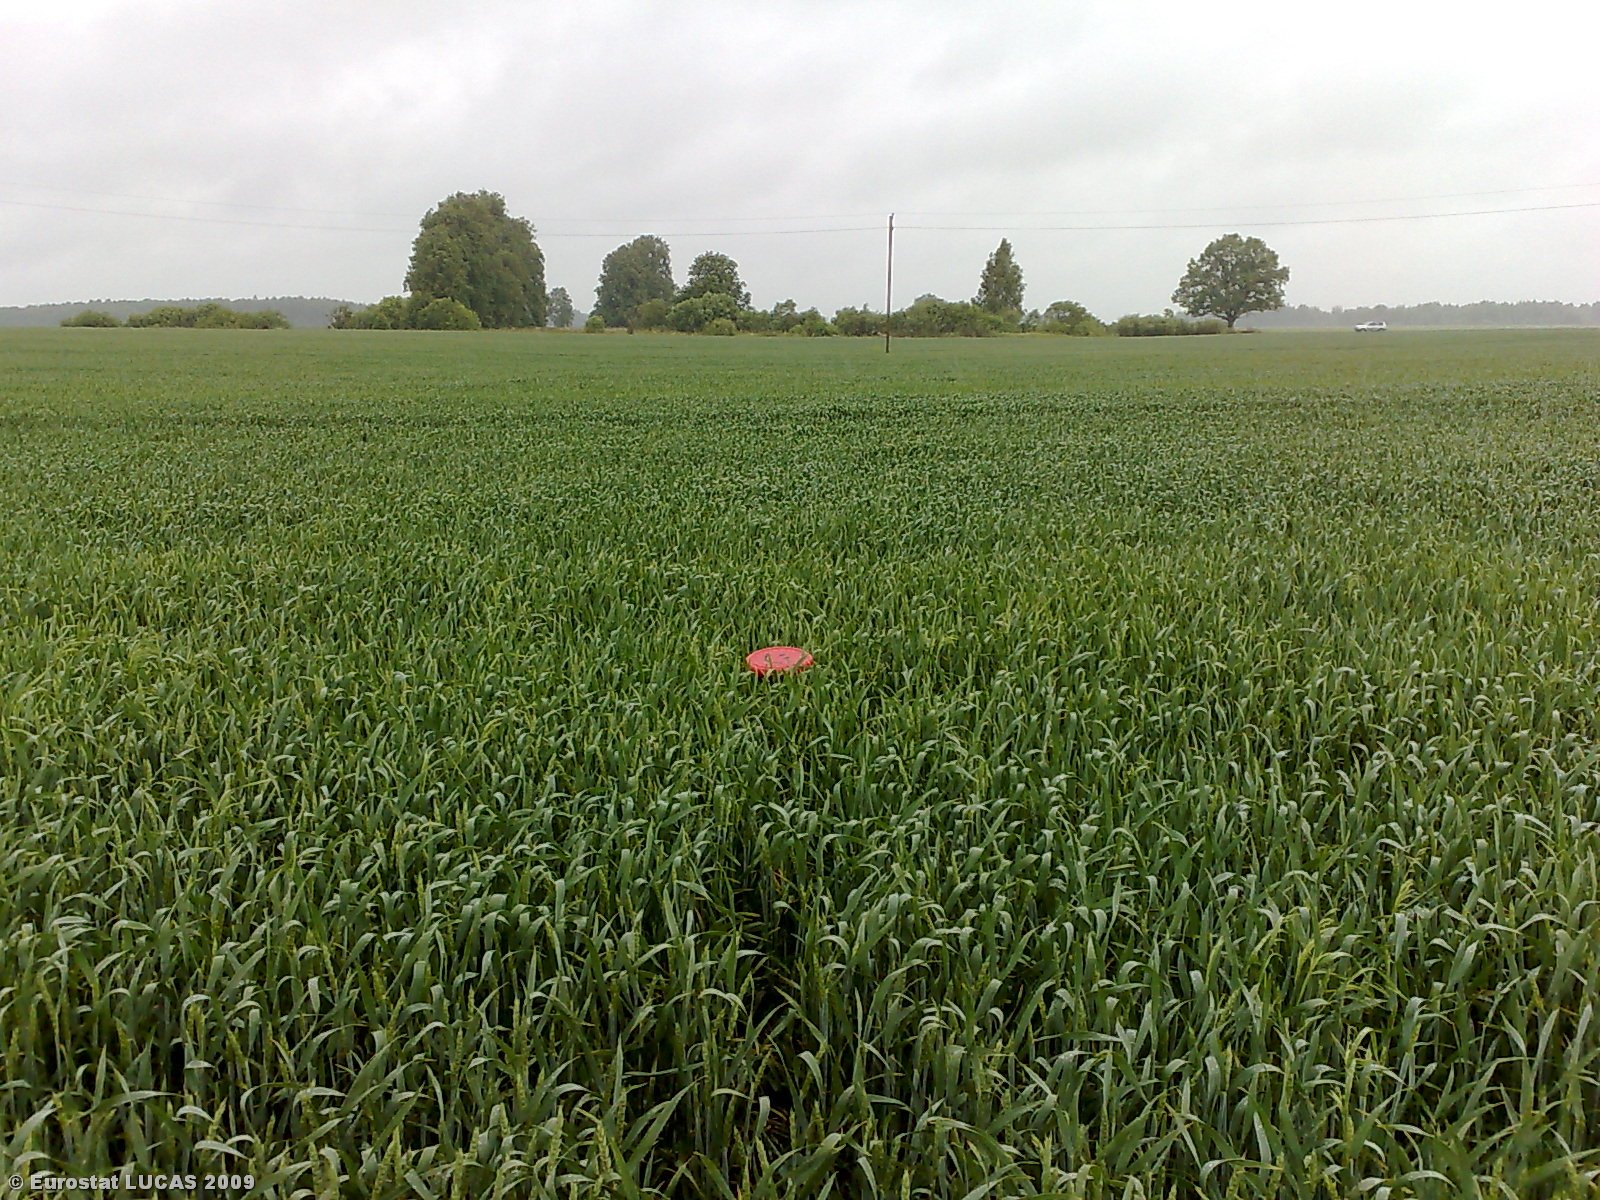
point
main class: Cropland
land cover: Common wheat
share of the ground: > 75 %
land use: Agriculture (excluding fallow land and kitchen gardens)
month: June
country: LT
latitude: 55.8677
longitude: 24.0392
